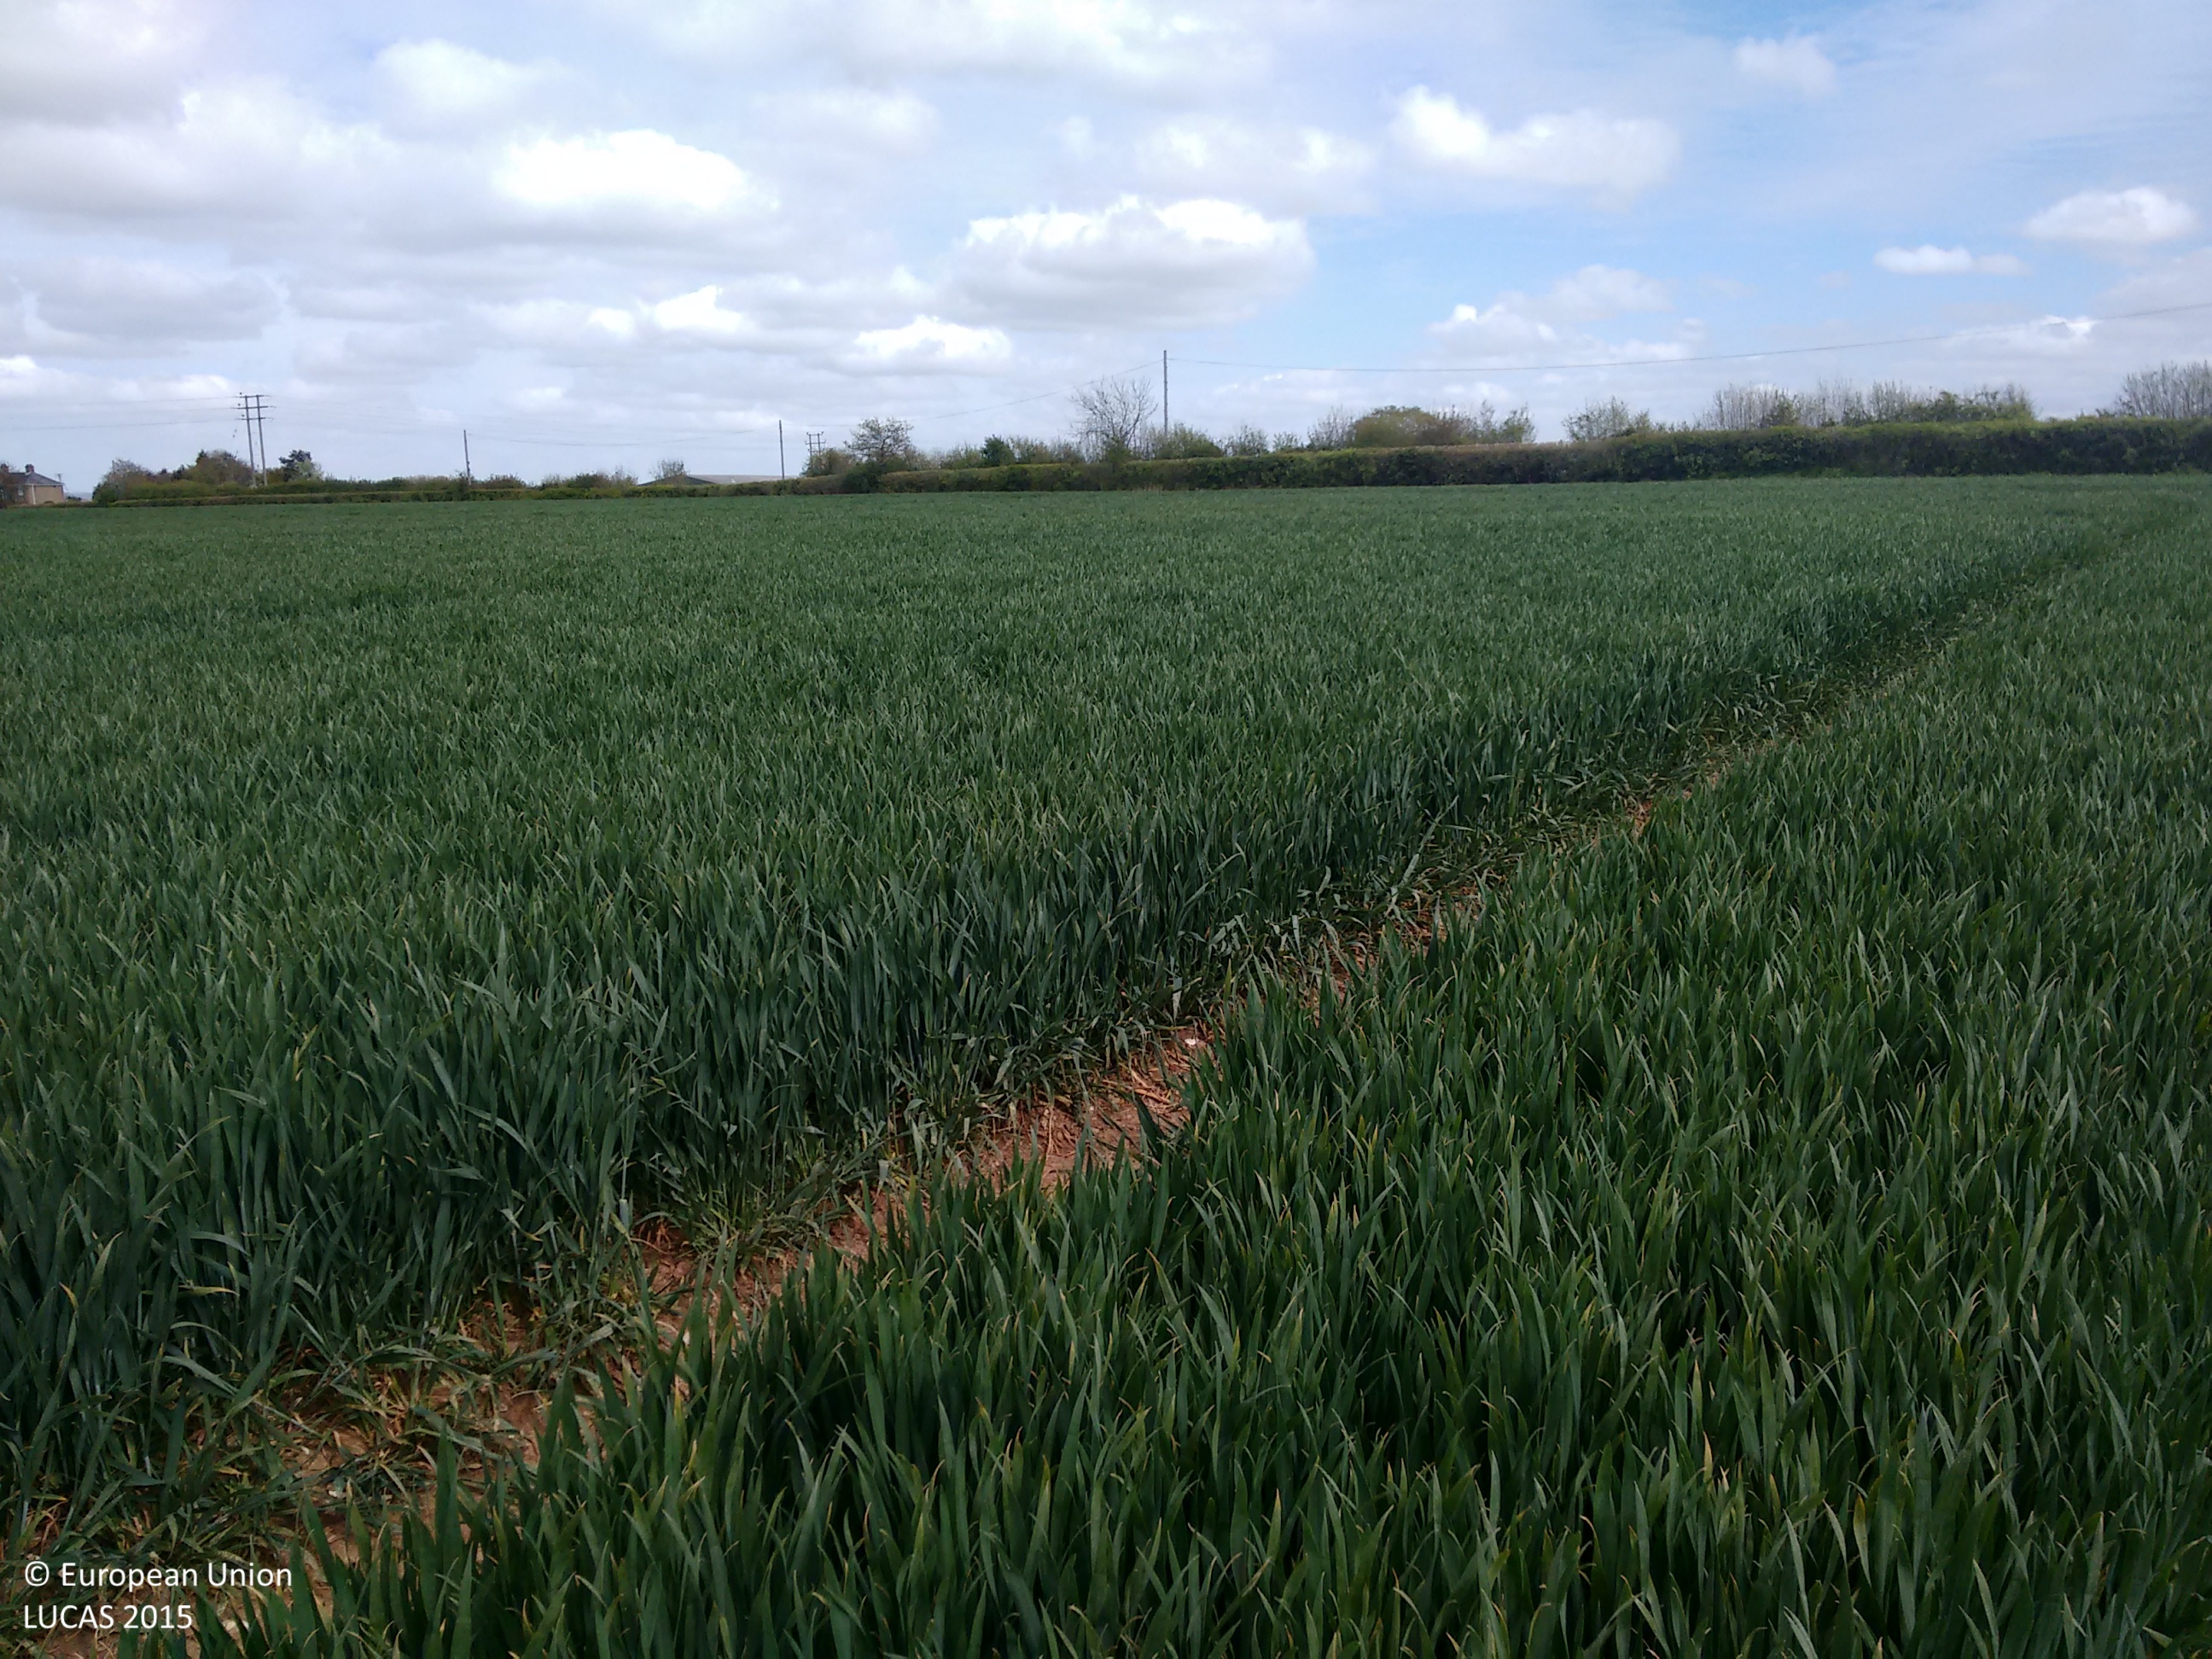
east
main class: Cropland
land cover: Common wheat
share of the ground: > 75 %
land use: Agriculture (excluding fallow land and kitchen gardens)
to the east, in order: Common wheat; Grass margins; Fences; Managed hedges; Grass margins; Paved roads, cycling and walking lanes; Grass margins; Fences; Managed hedges; Electric lines; Common wheat; Single bushes/trees; Common wheat
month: May
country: GB
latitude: 51.3231
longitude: 0.6895
